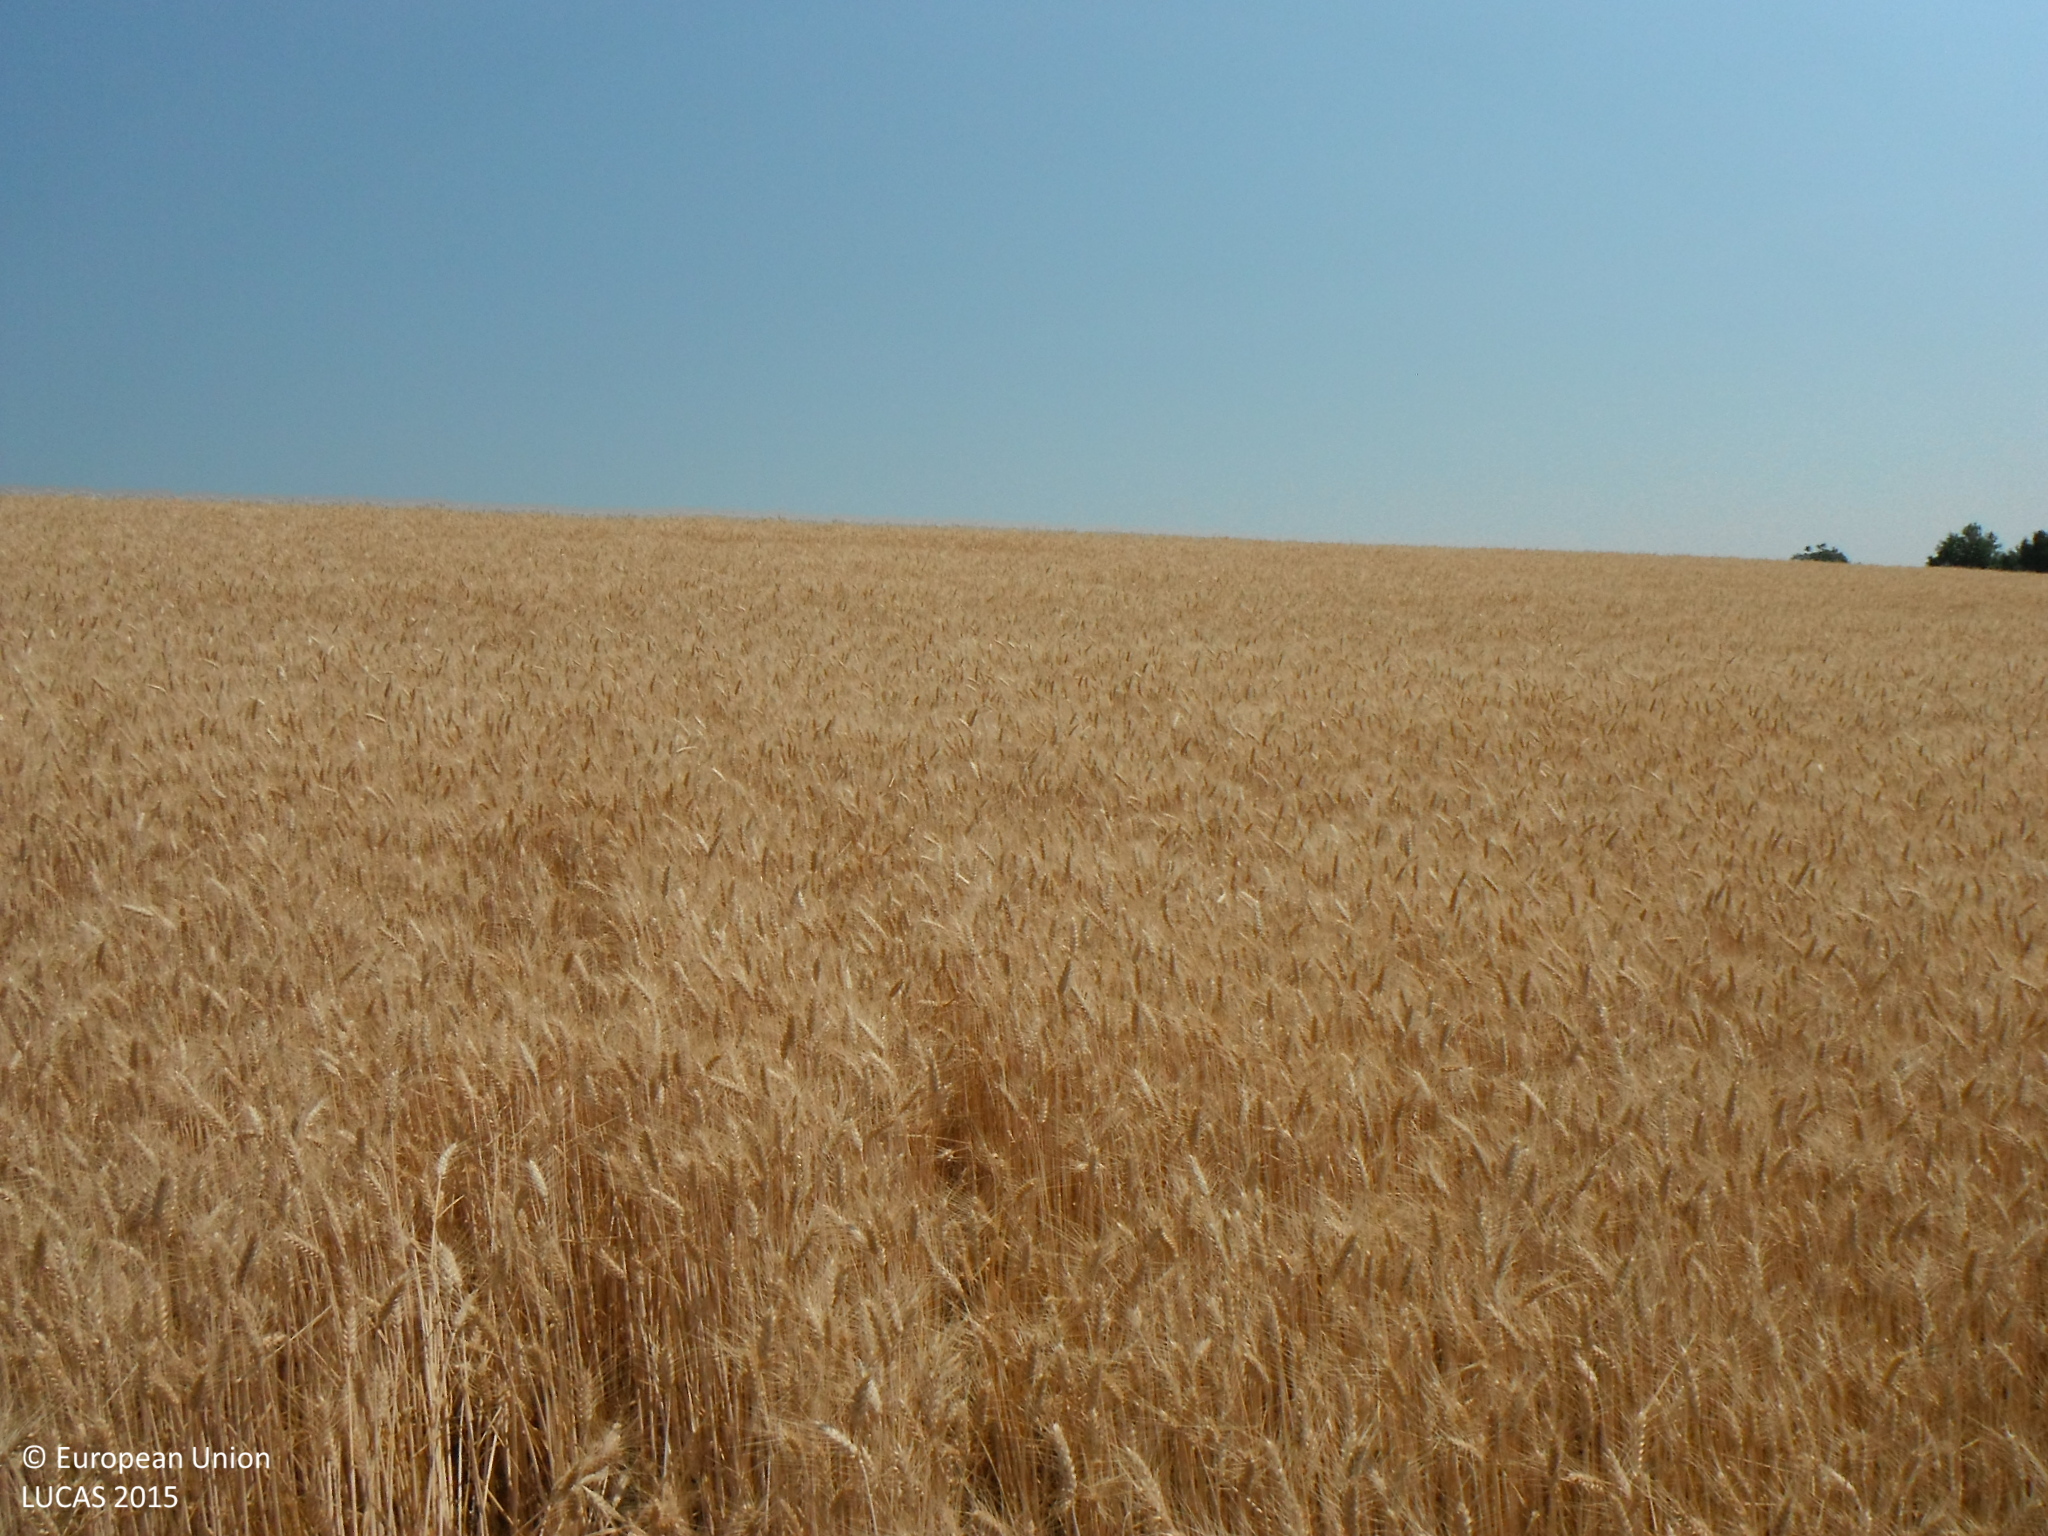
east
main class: Cropland
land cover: Common wheat
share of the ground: > 75 %
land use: Agriculture (excluding fallow land and kitchen gardens)
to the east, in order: Common wheat; Lines of trees; Paved roads, cycling and walking lanes; Lines of trees; Grassland without tree/shrub cover
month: July
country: SK
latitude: 48.2061
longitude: 19.1307
